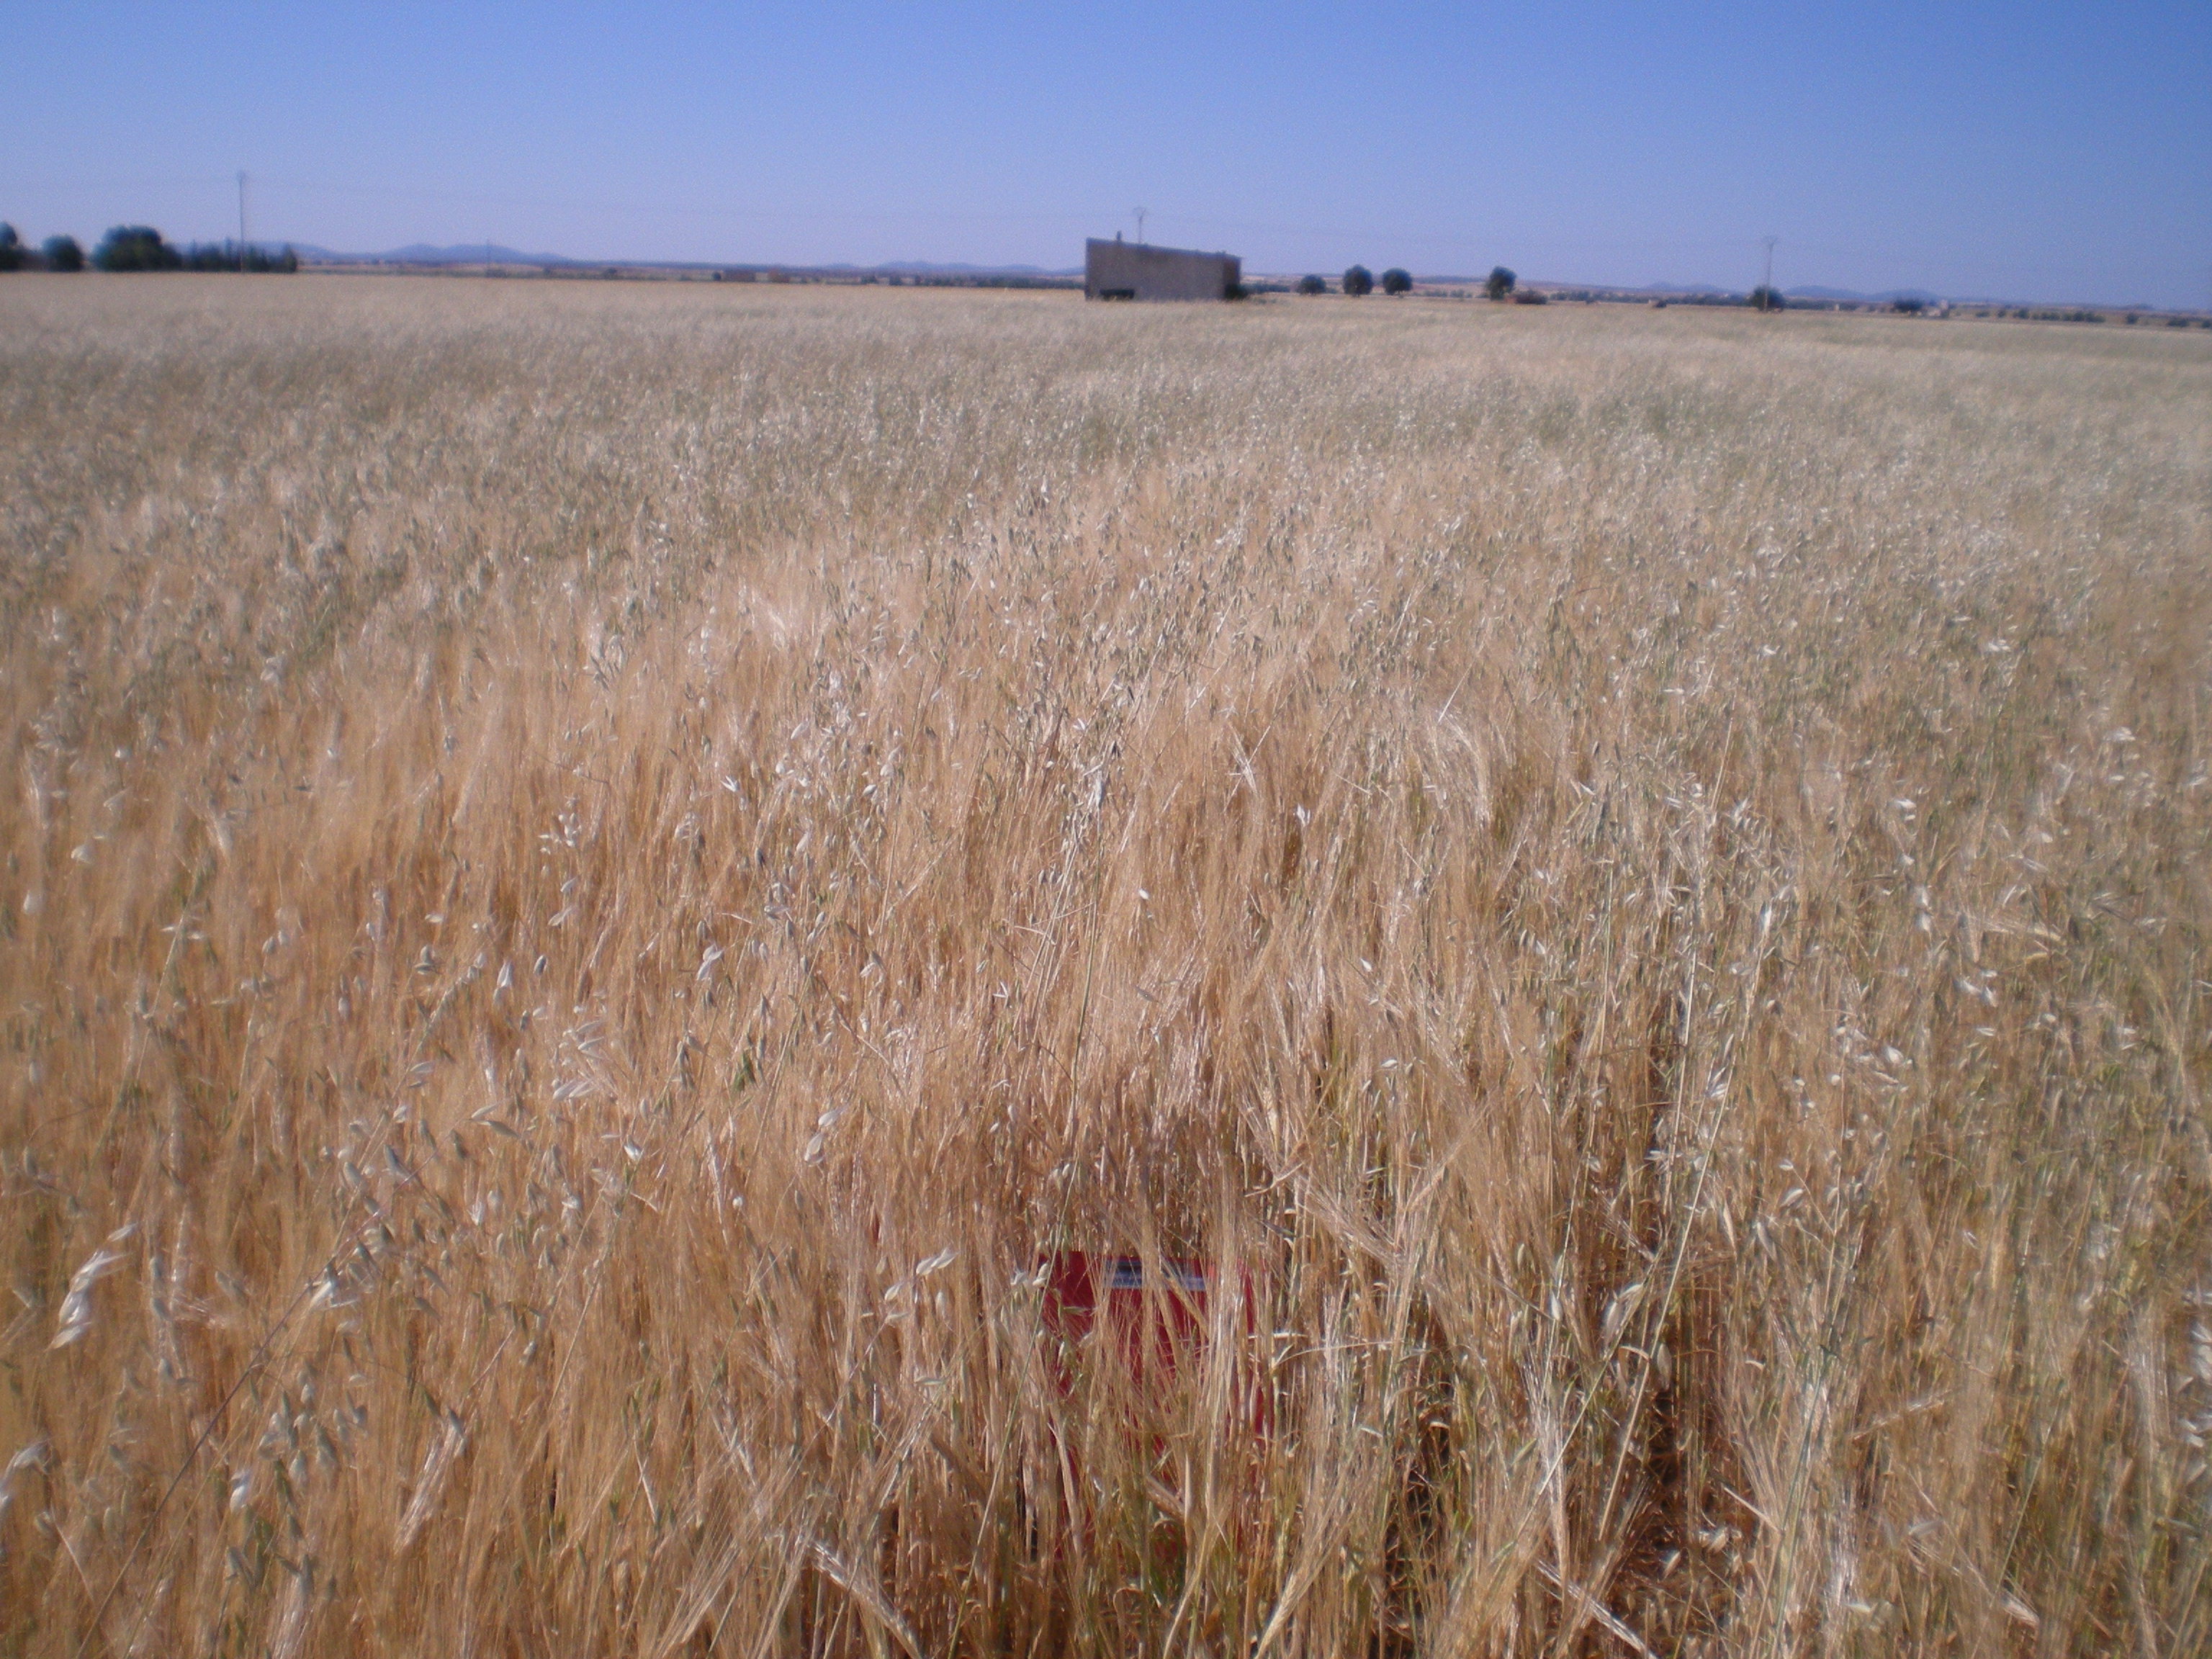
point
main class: Cropland
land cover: Barley
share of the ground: > 75 %
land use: Agriculture (excluding fallow land and kitchen gardens)
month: May
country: ES
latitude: 39.1071
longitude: -3.2554
